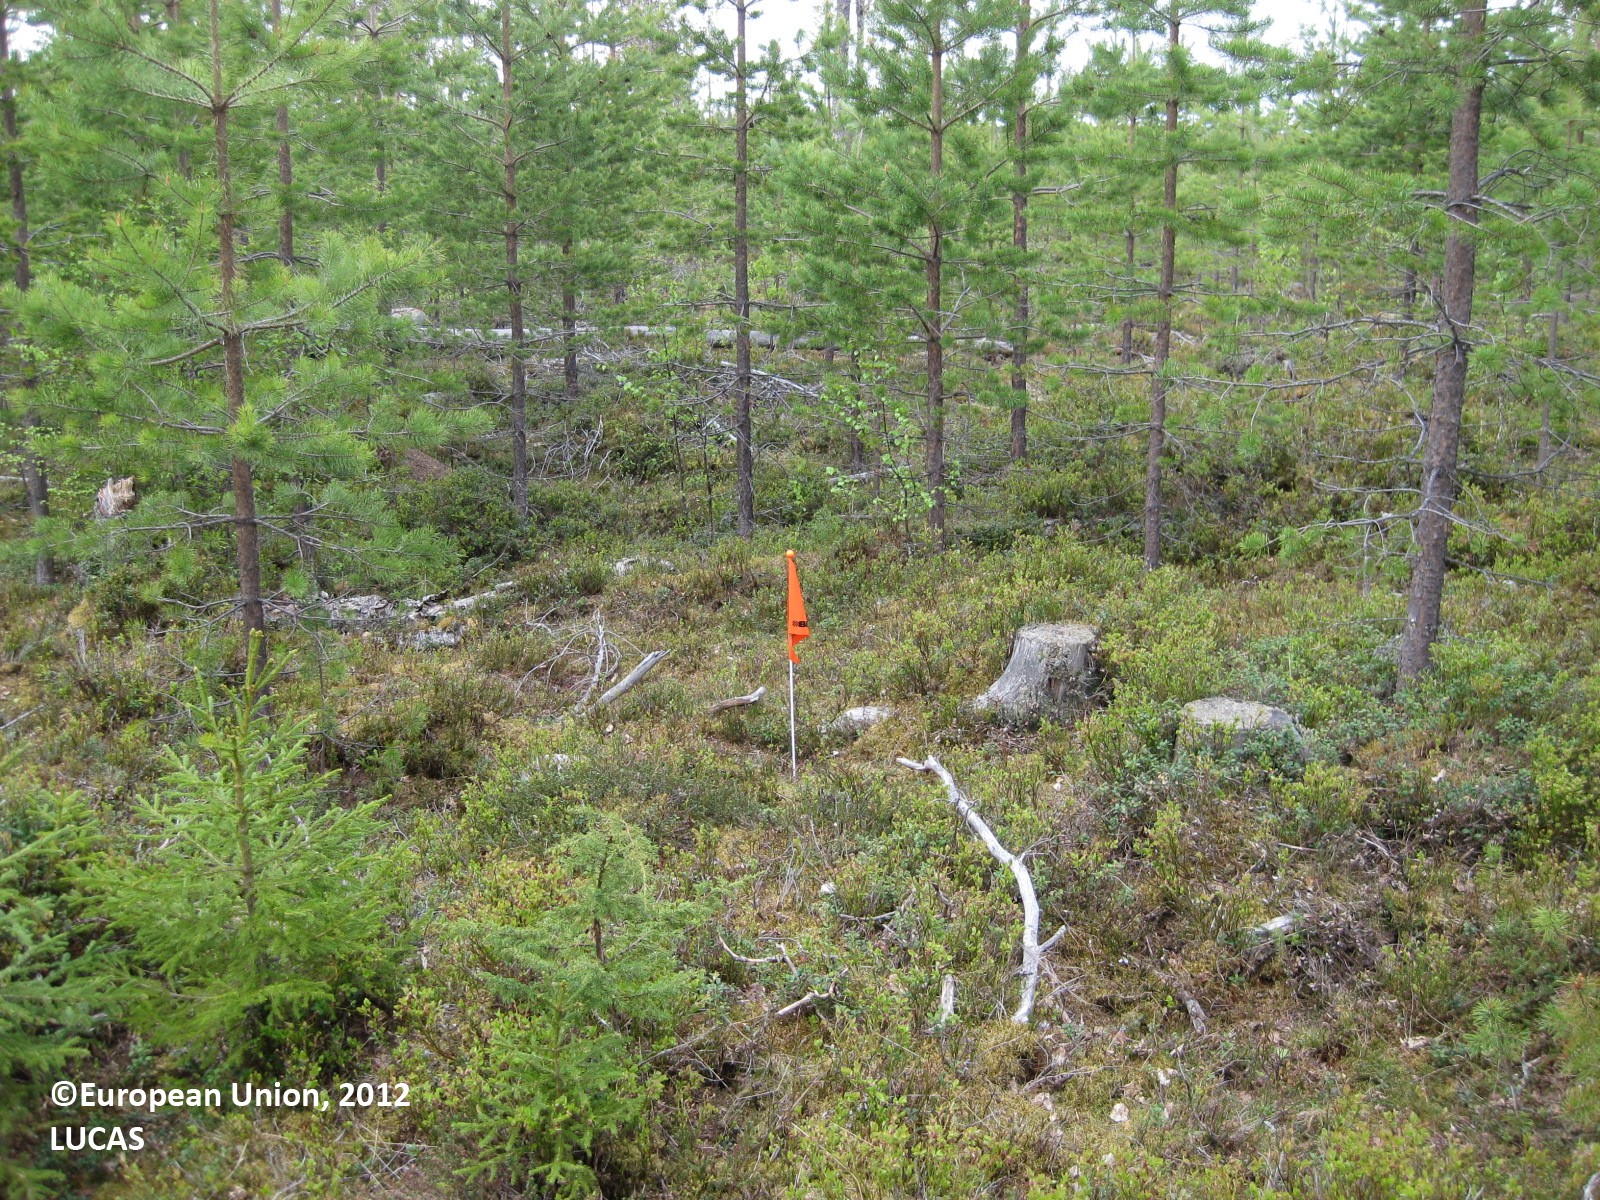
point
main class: Woodland
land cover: Pine dominated coniferous woodland
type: boreal forest
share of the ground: 50 - 75 %
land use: Forestry
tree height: < 5 m
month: June
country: FI
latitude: 65.3672
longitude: 29.3084
